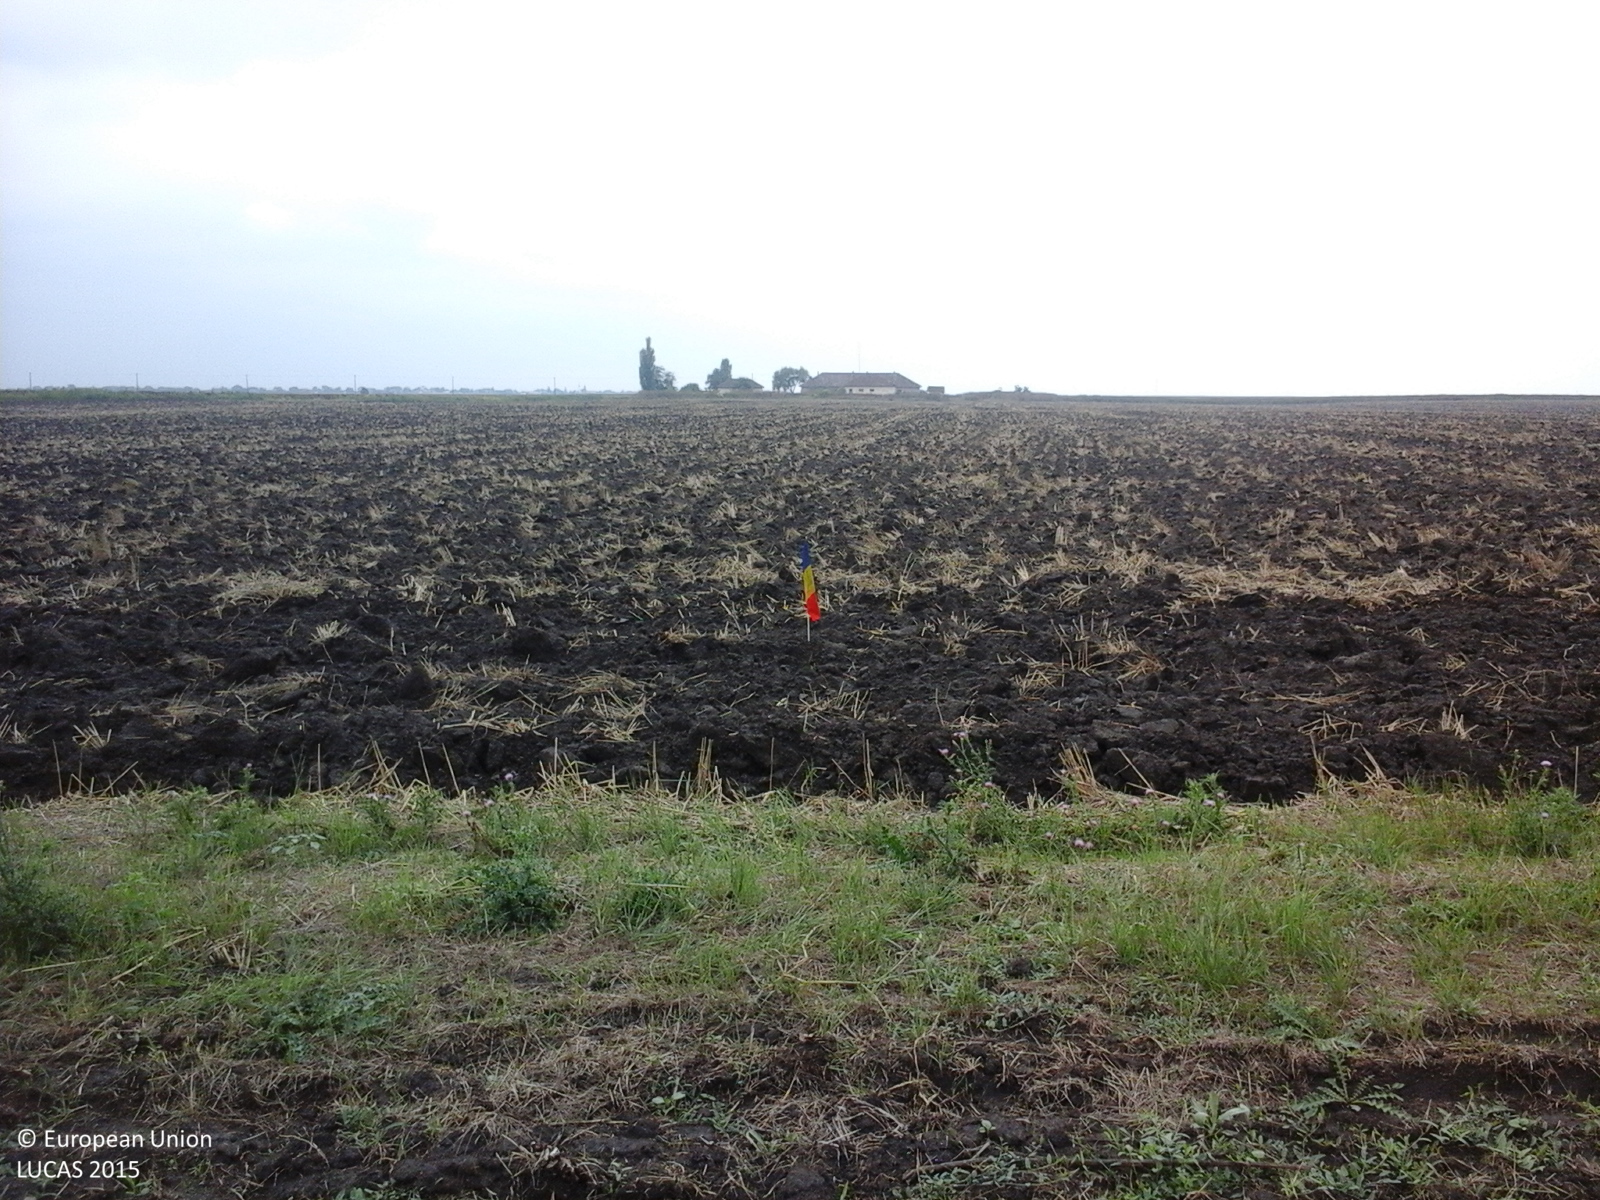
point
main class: Cropland
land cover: Common wheat
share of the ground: < 10 %
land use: Agriculture (excluding fallow land and kitchen gardens)
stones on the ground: < 10 %
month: August
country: RO
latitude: 46.1520
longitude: 20.3951
